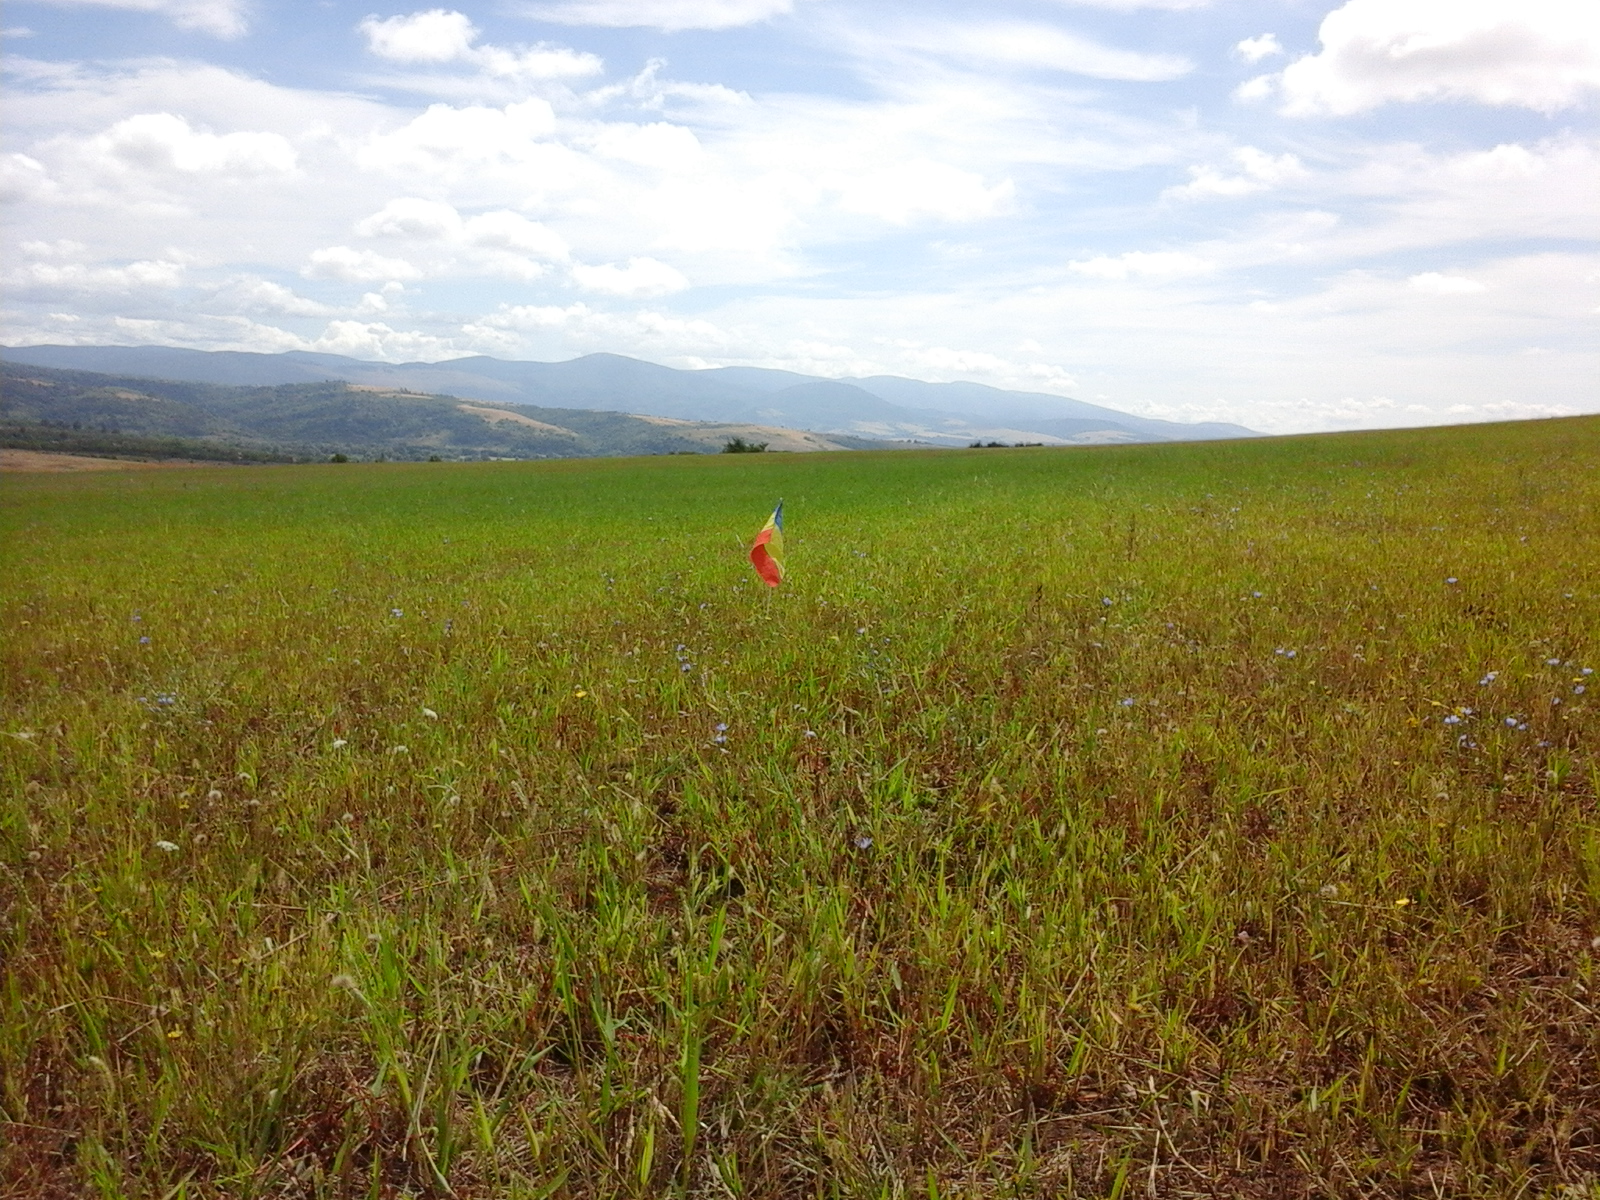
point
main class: Grassland
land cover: Grassland without tree/shrub cover
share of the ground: > 75 %
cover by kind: herbaceous plants 100 %
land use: Agriculture (excluding fallow land and kitchen gardens)
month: August
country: RO
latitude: 45.1517
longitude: 21.6190
